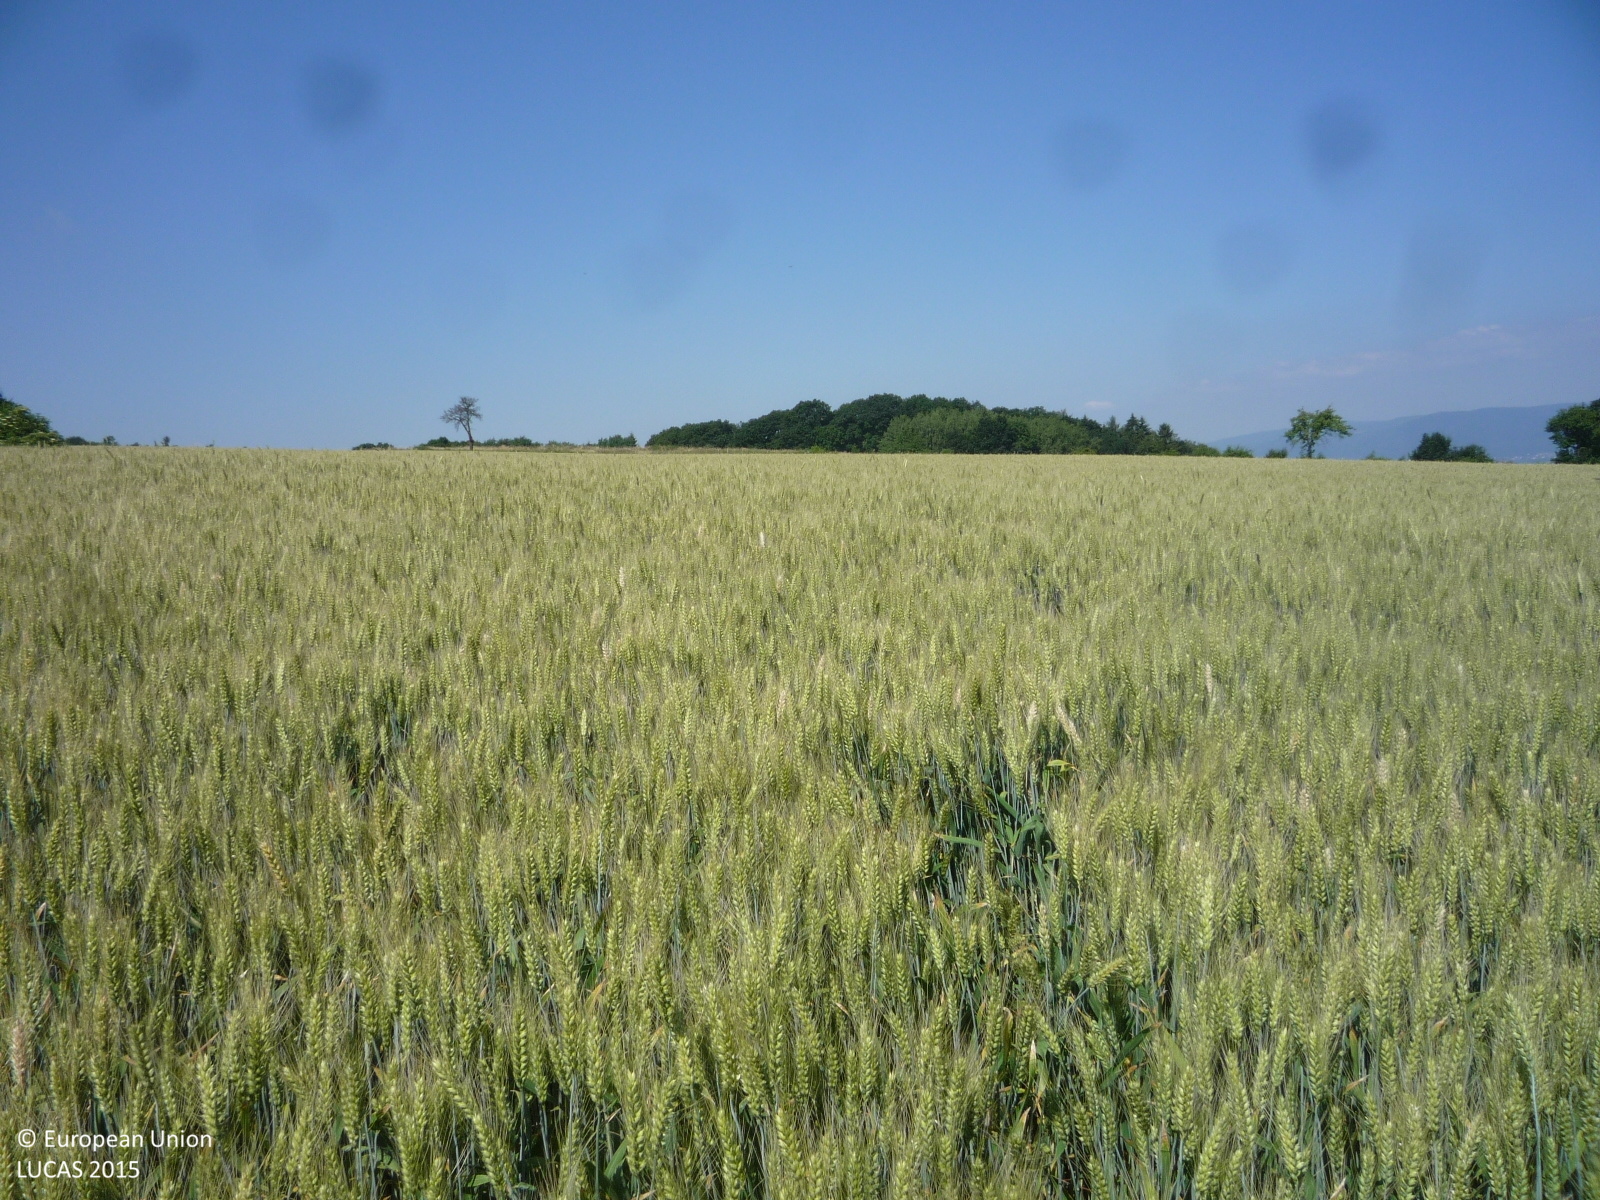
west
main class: Cropland
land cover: Common wheat
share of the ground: > 75 %
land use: Agriculture (excluding fallow land and kitchen gardens)
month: July
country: CZ
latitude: 50.5682
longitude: 13.8835
